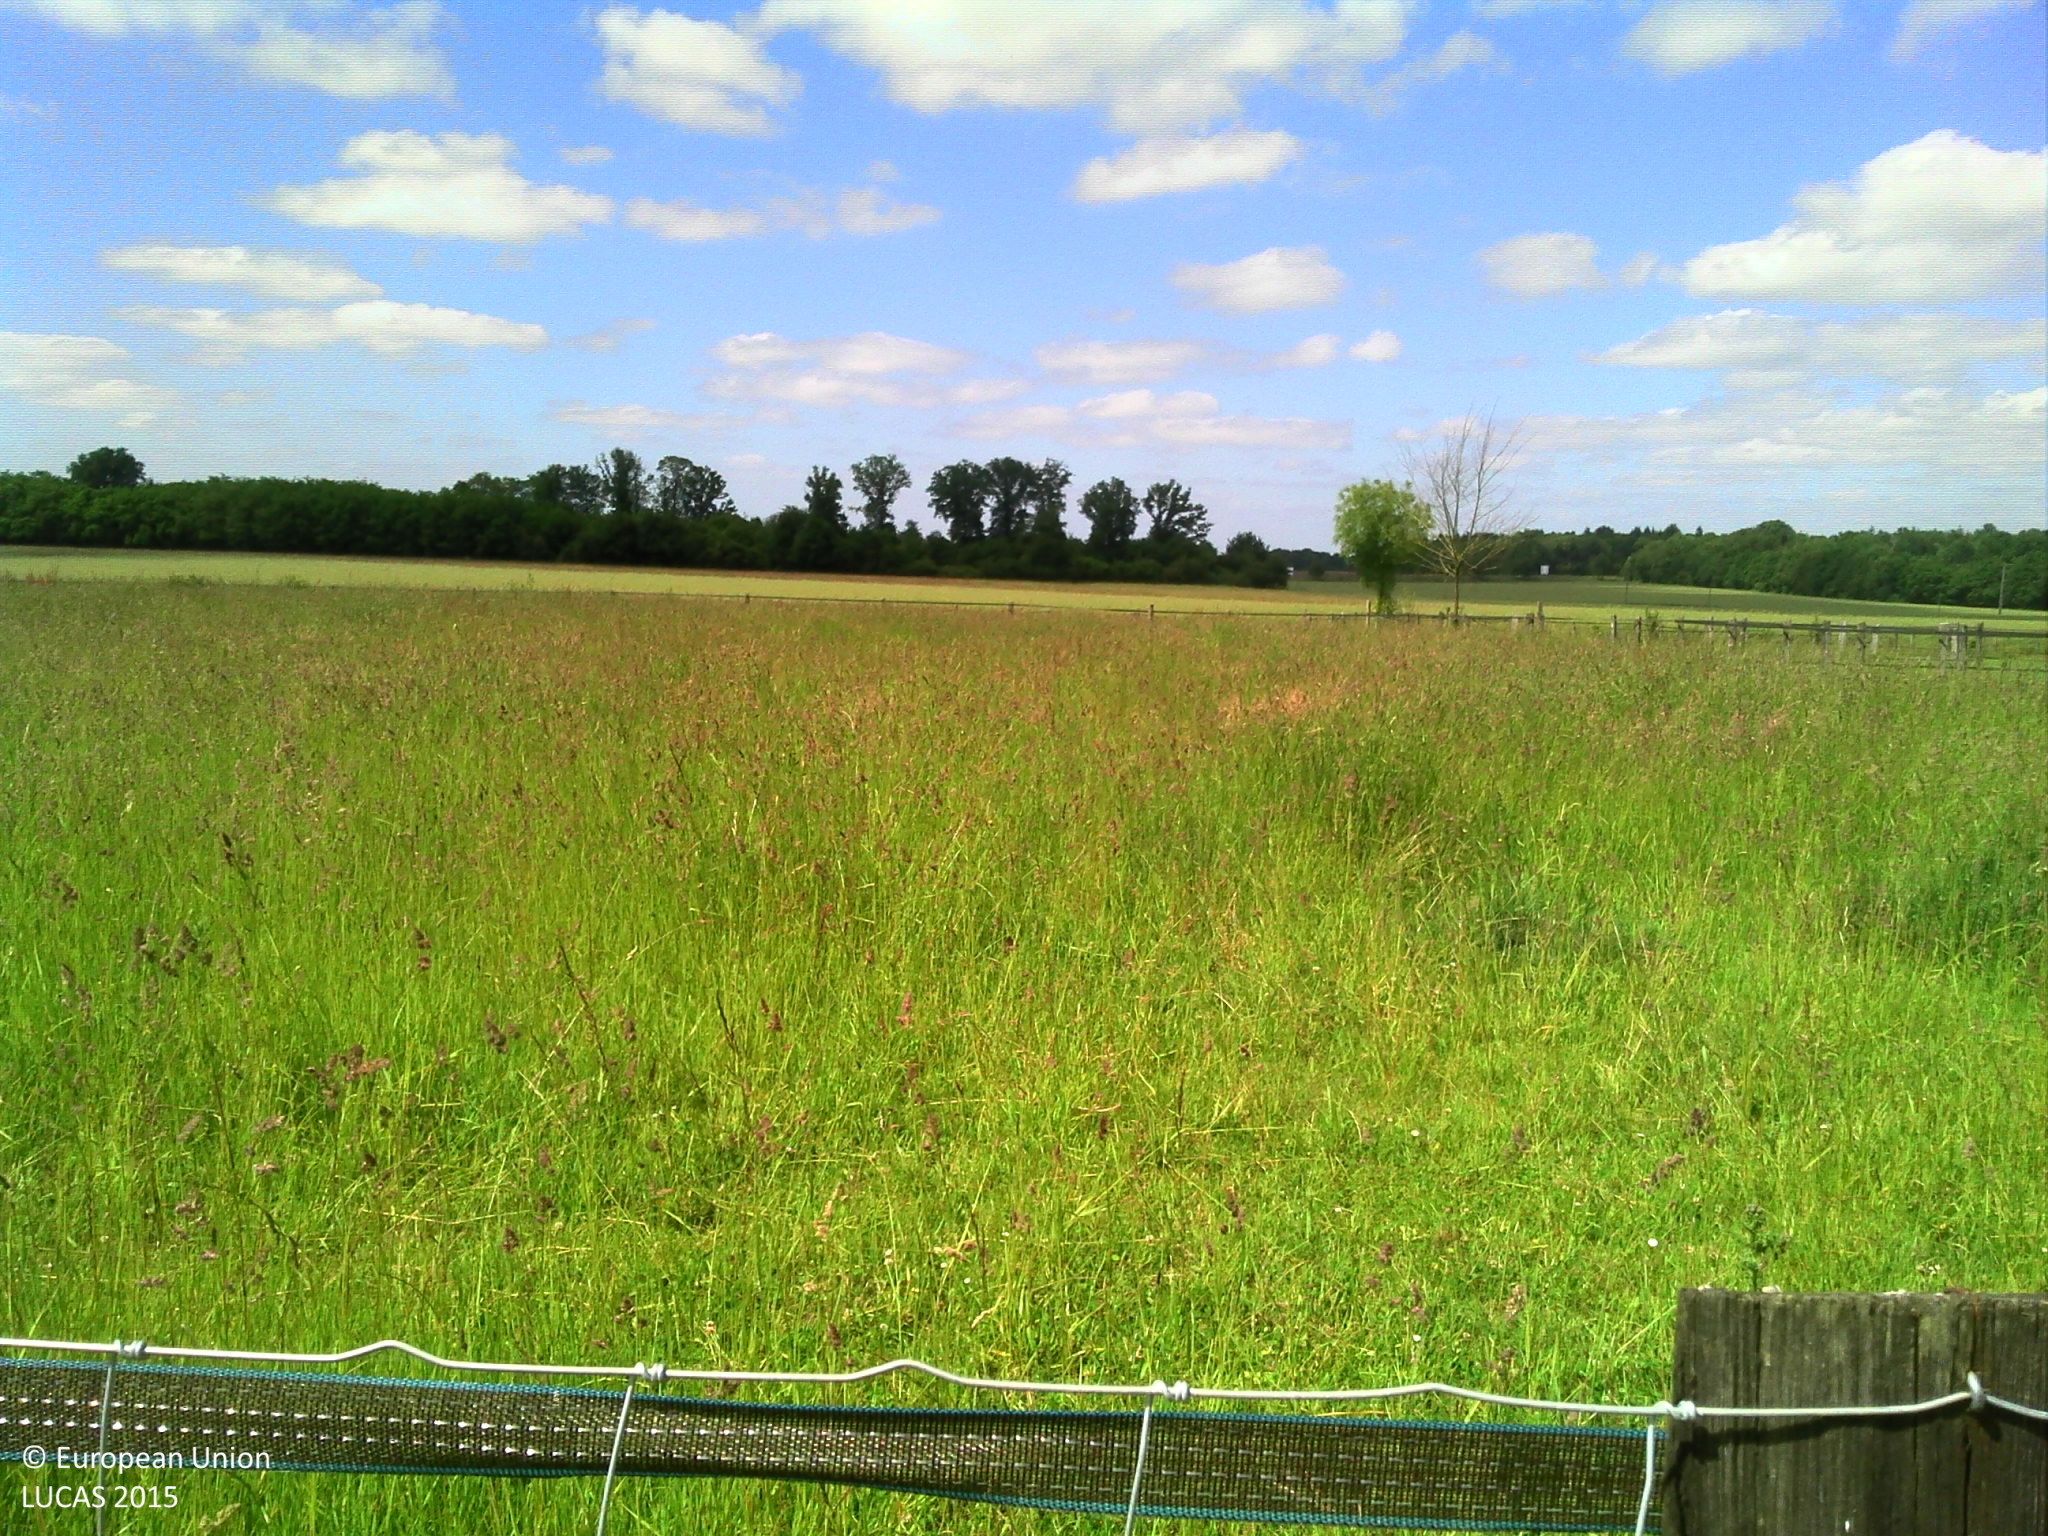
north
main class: Grassland
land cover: Grassland without tree/shrub cover
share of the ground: > 75 %
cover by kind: herbaceous plants 100 %
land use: Agriculture (excluding fallow land and kitchen gardens)
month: June
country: FR
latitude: 47.4747
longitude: 0.7857
